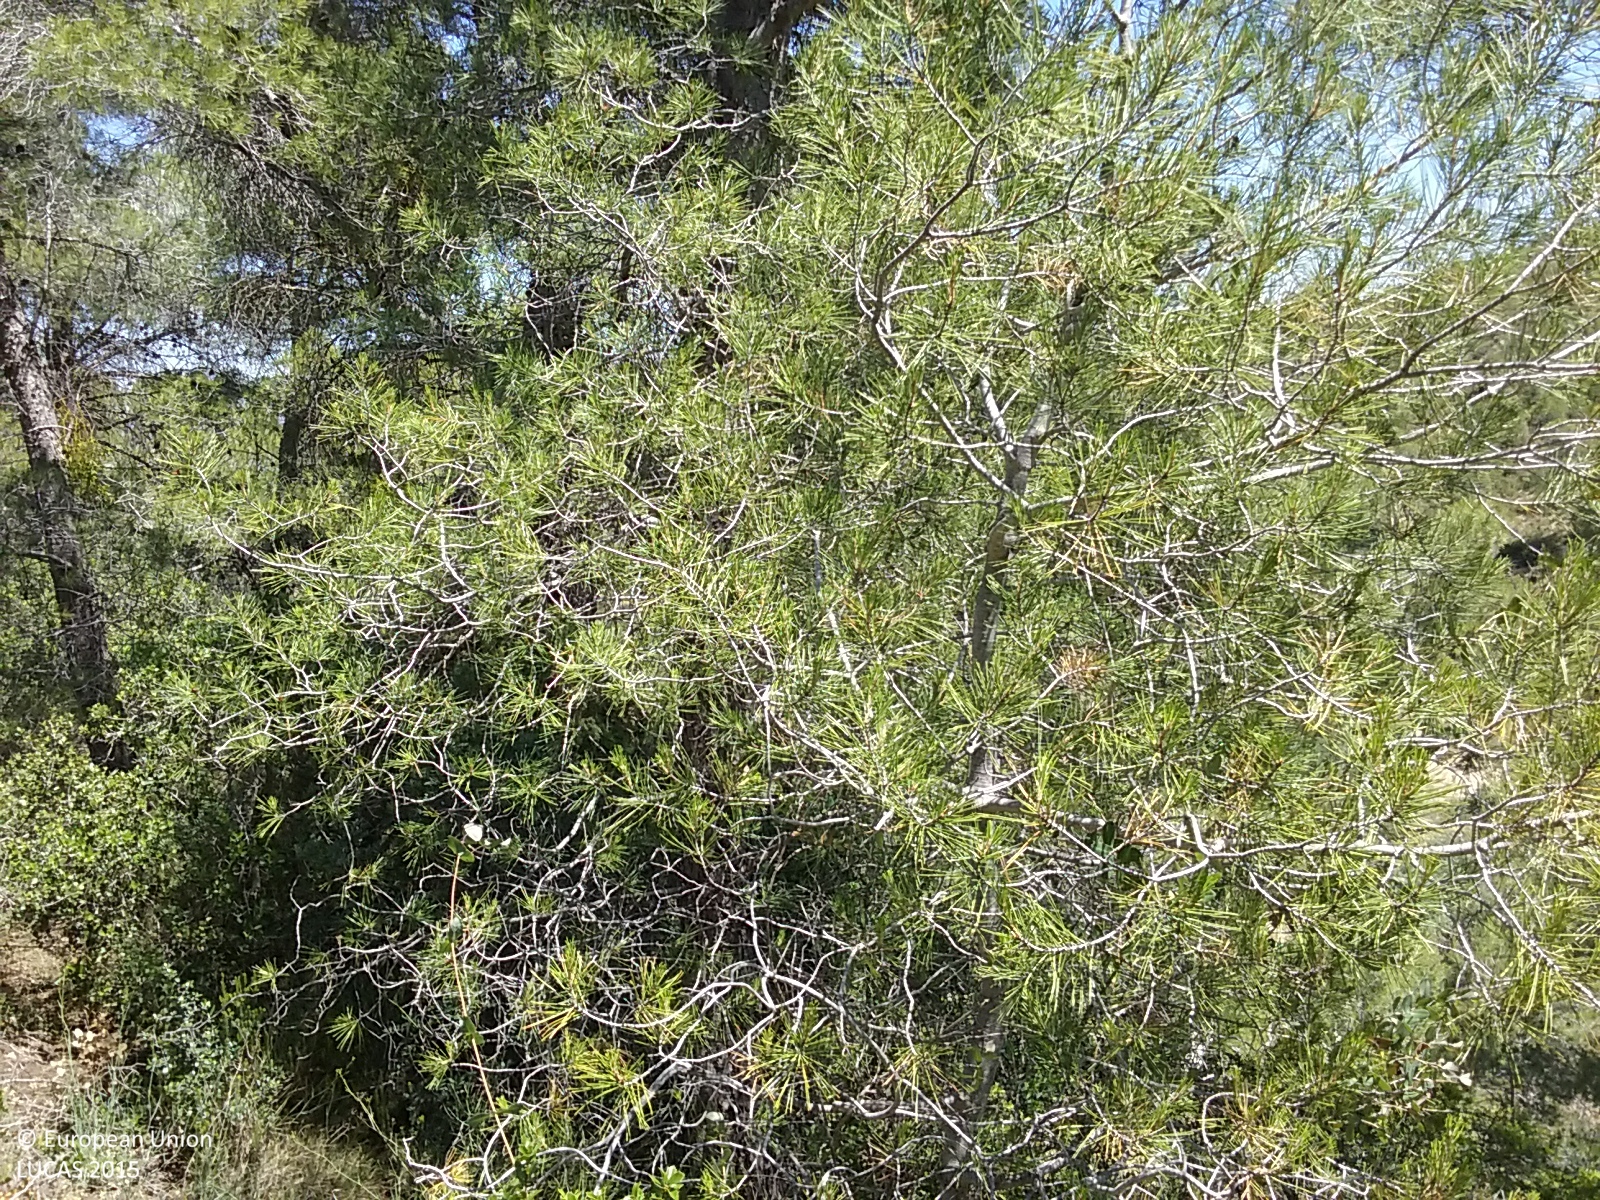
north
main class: Woodland
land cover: Pine dominated coniferous woodland
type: coniferous forest of the mediterranean region
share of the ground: > 75 %
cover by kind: coniferous forest trees 80 %, shrubs 20 %
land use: Semi-natural and natural areas not in use
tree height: > 5 m
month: June
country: ES
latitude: 41.2053
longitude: 0.4857
